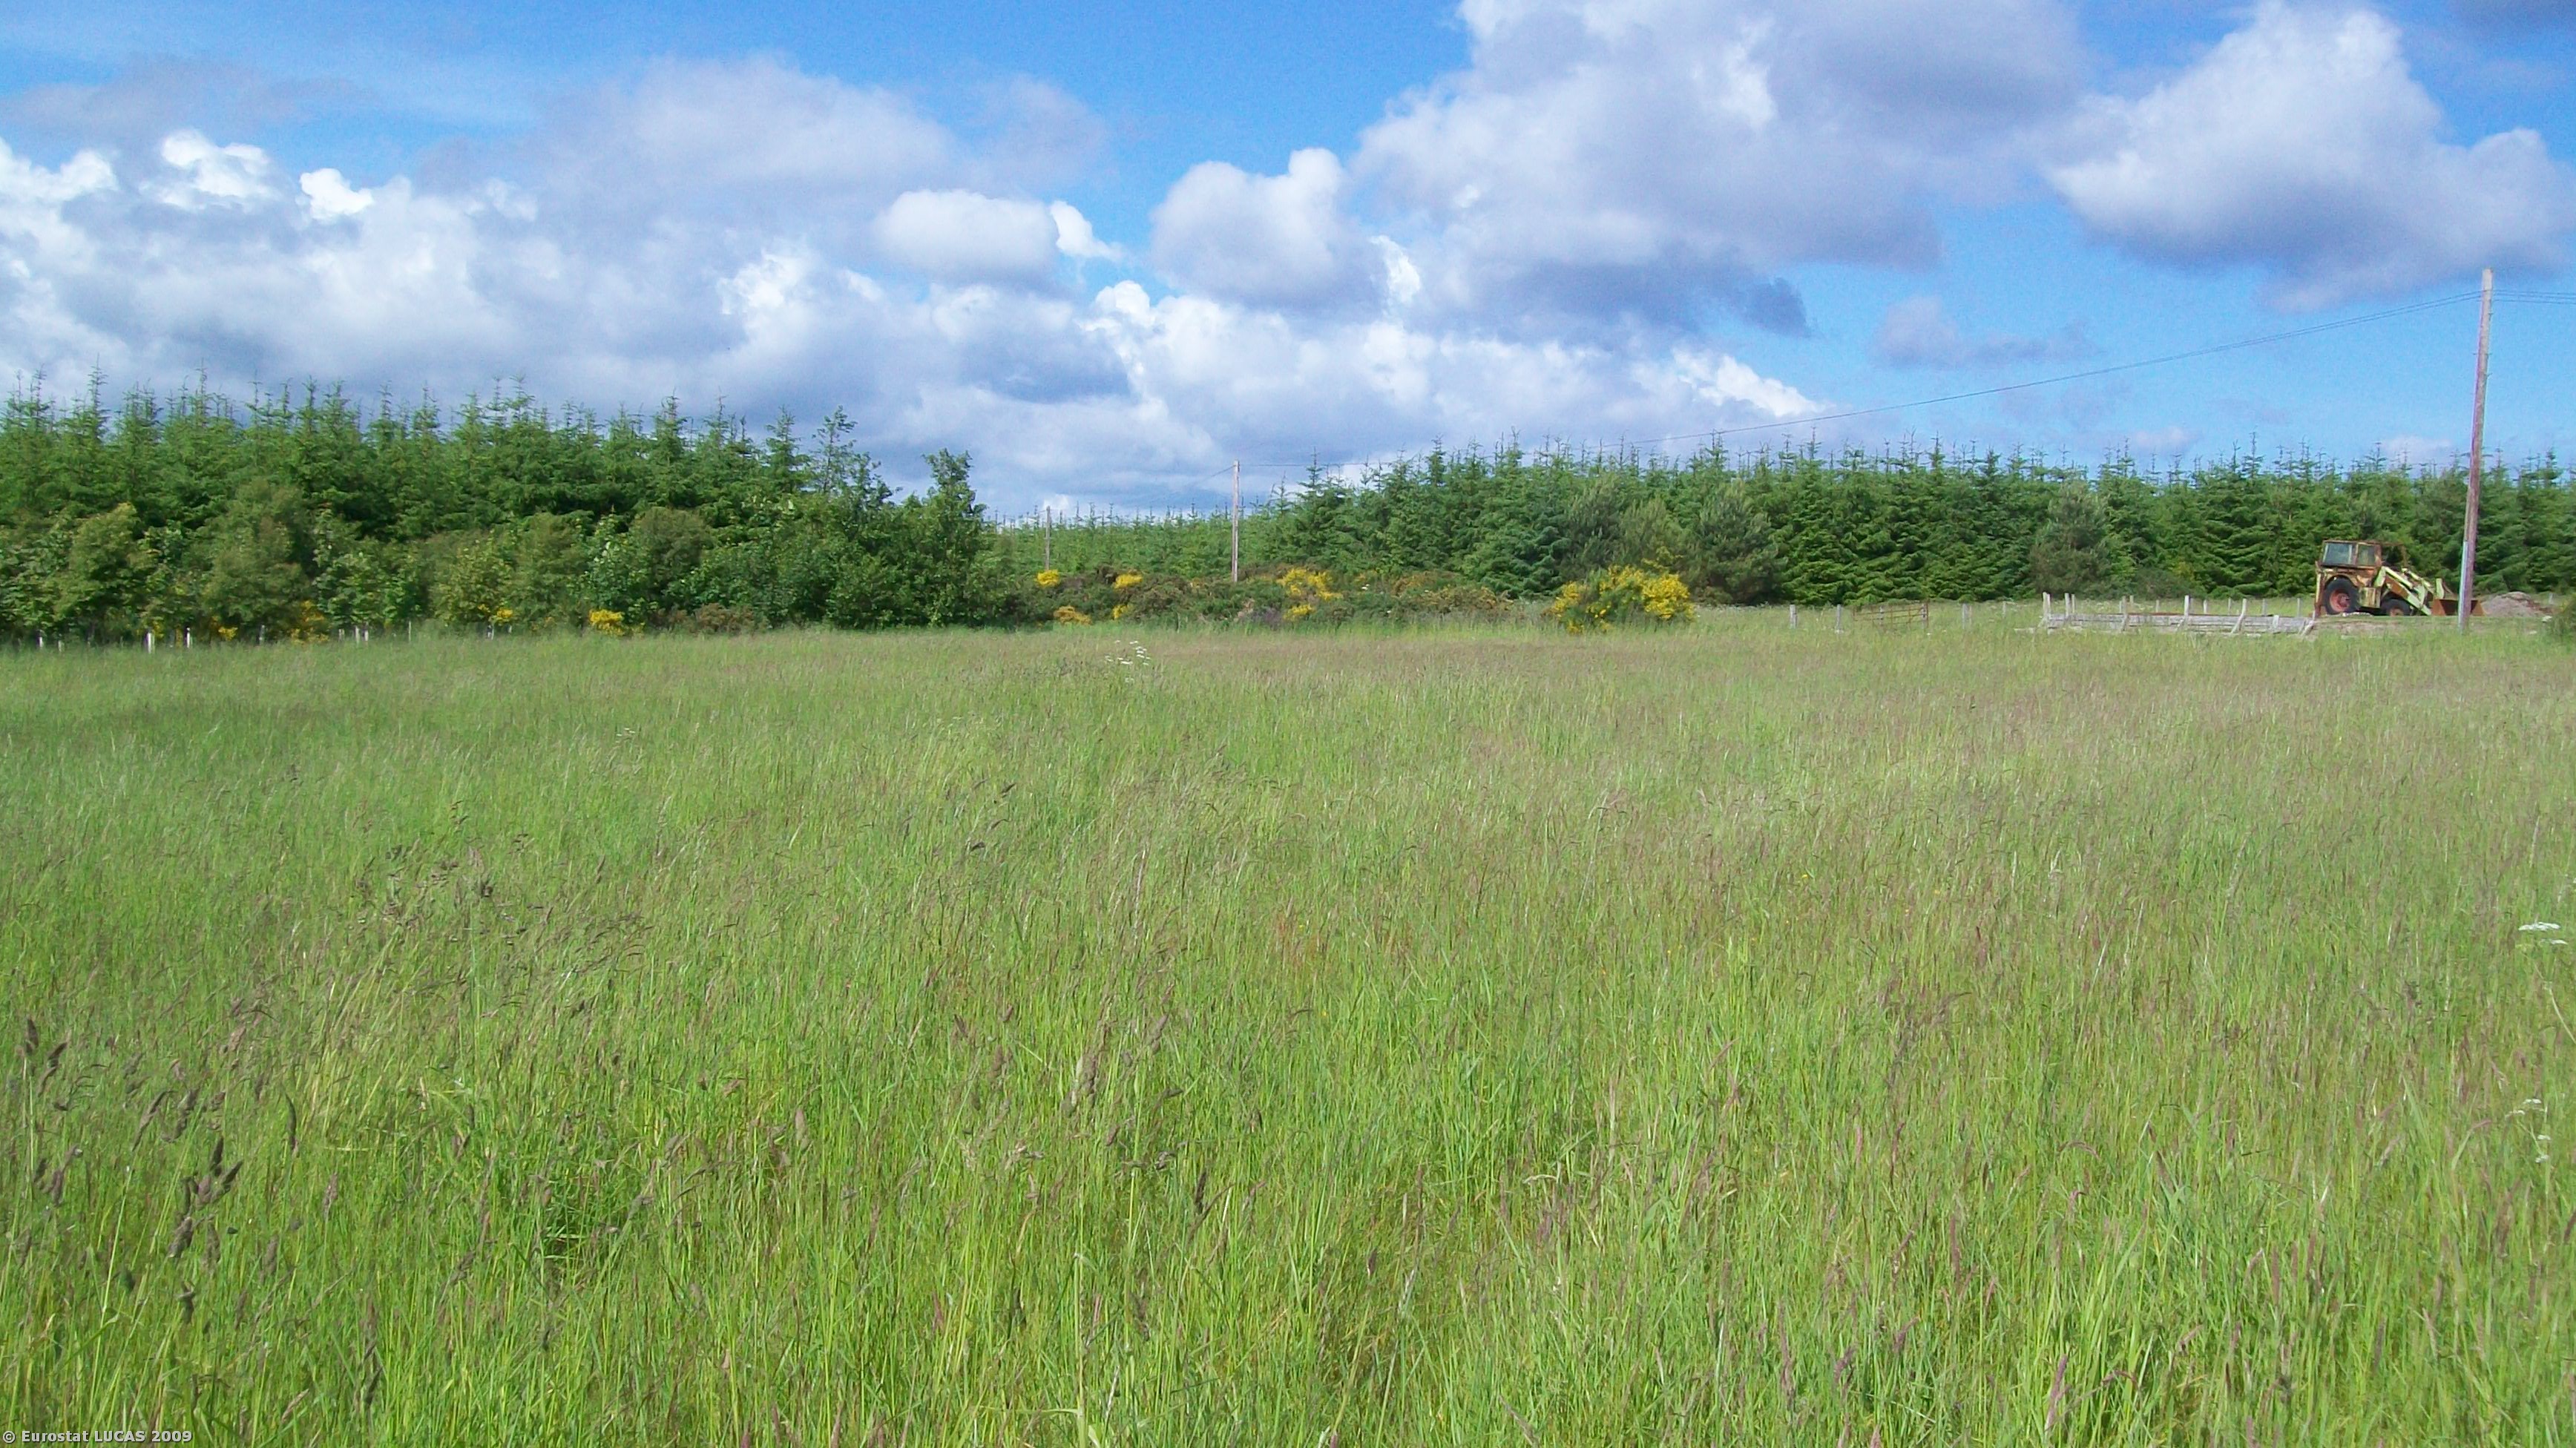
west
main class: Grassland
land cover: Grassland without tree/shrub cover
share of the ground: > 75 %
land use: Fallow land
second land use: Nature reserves
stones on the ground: 10 - 25 %
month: June
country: GB
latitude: 57.6867
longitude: -2.8896
